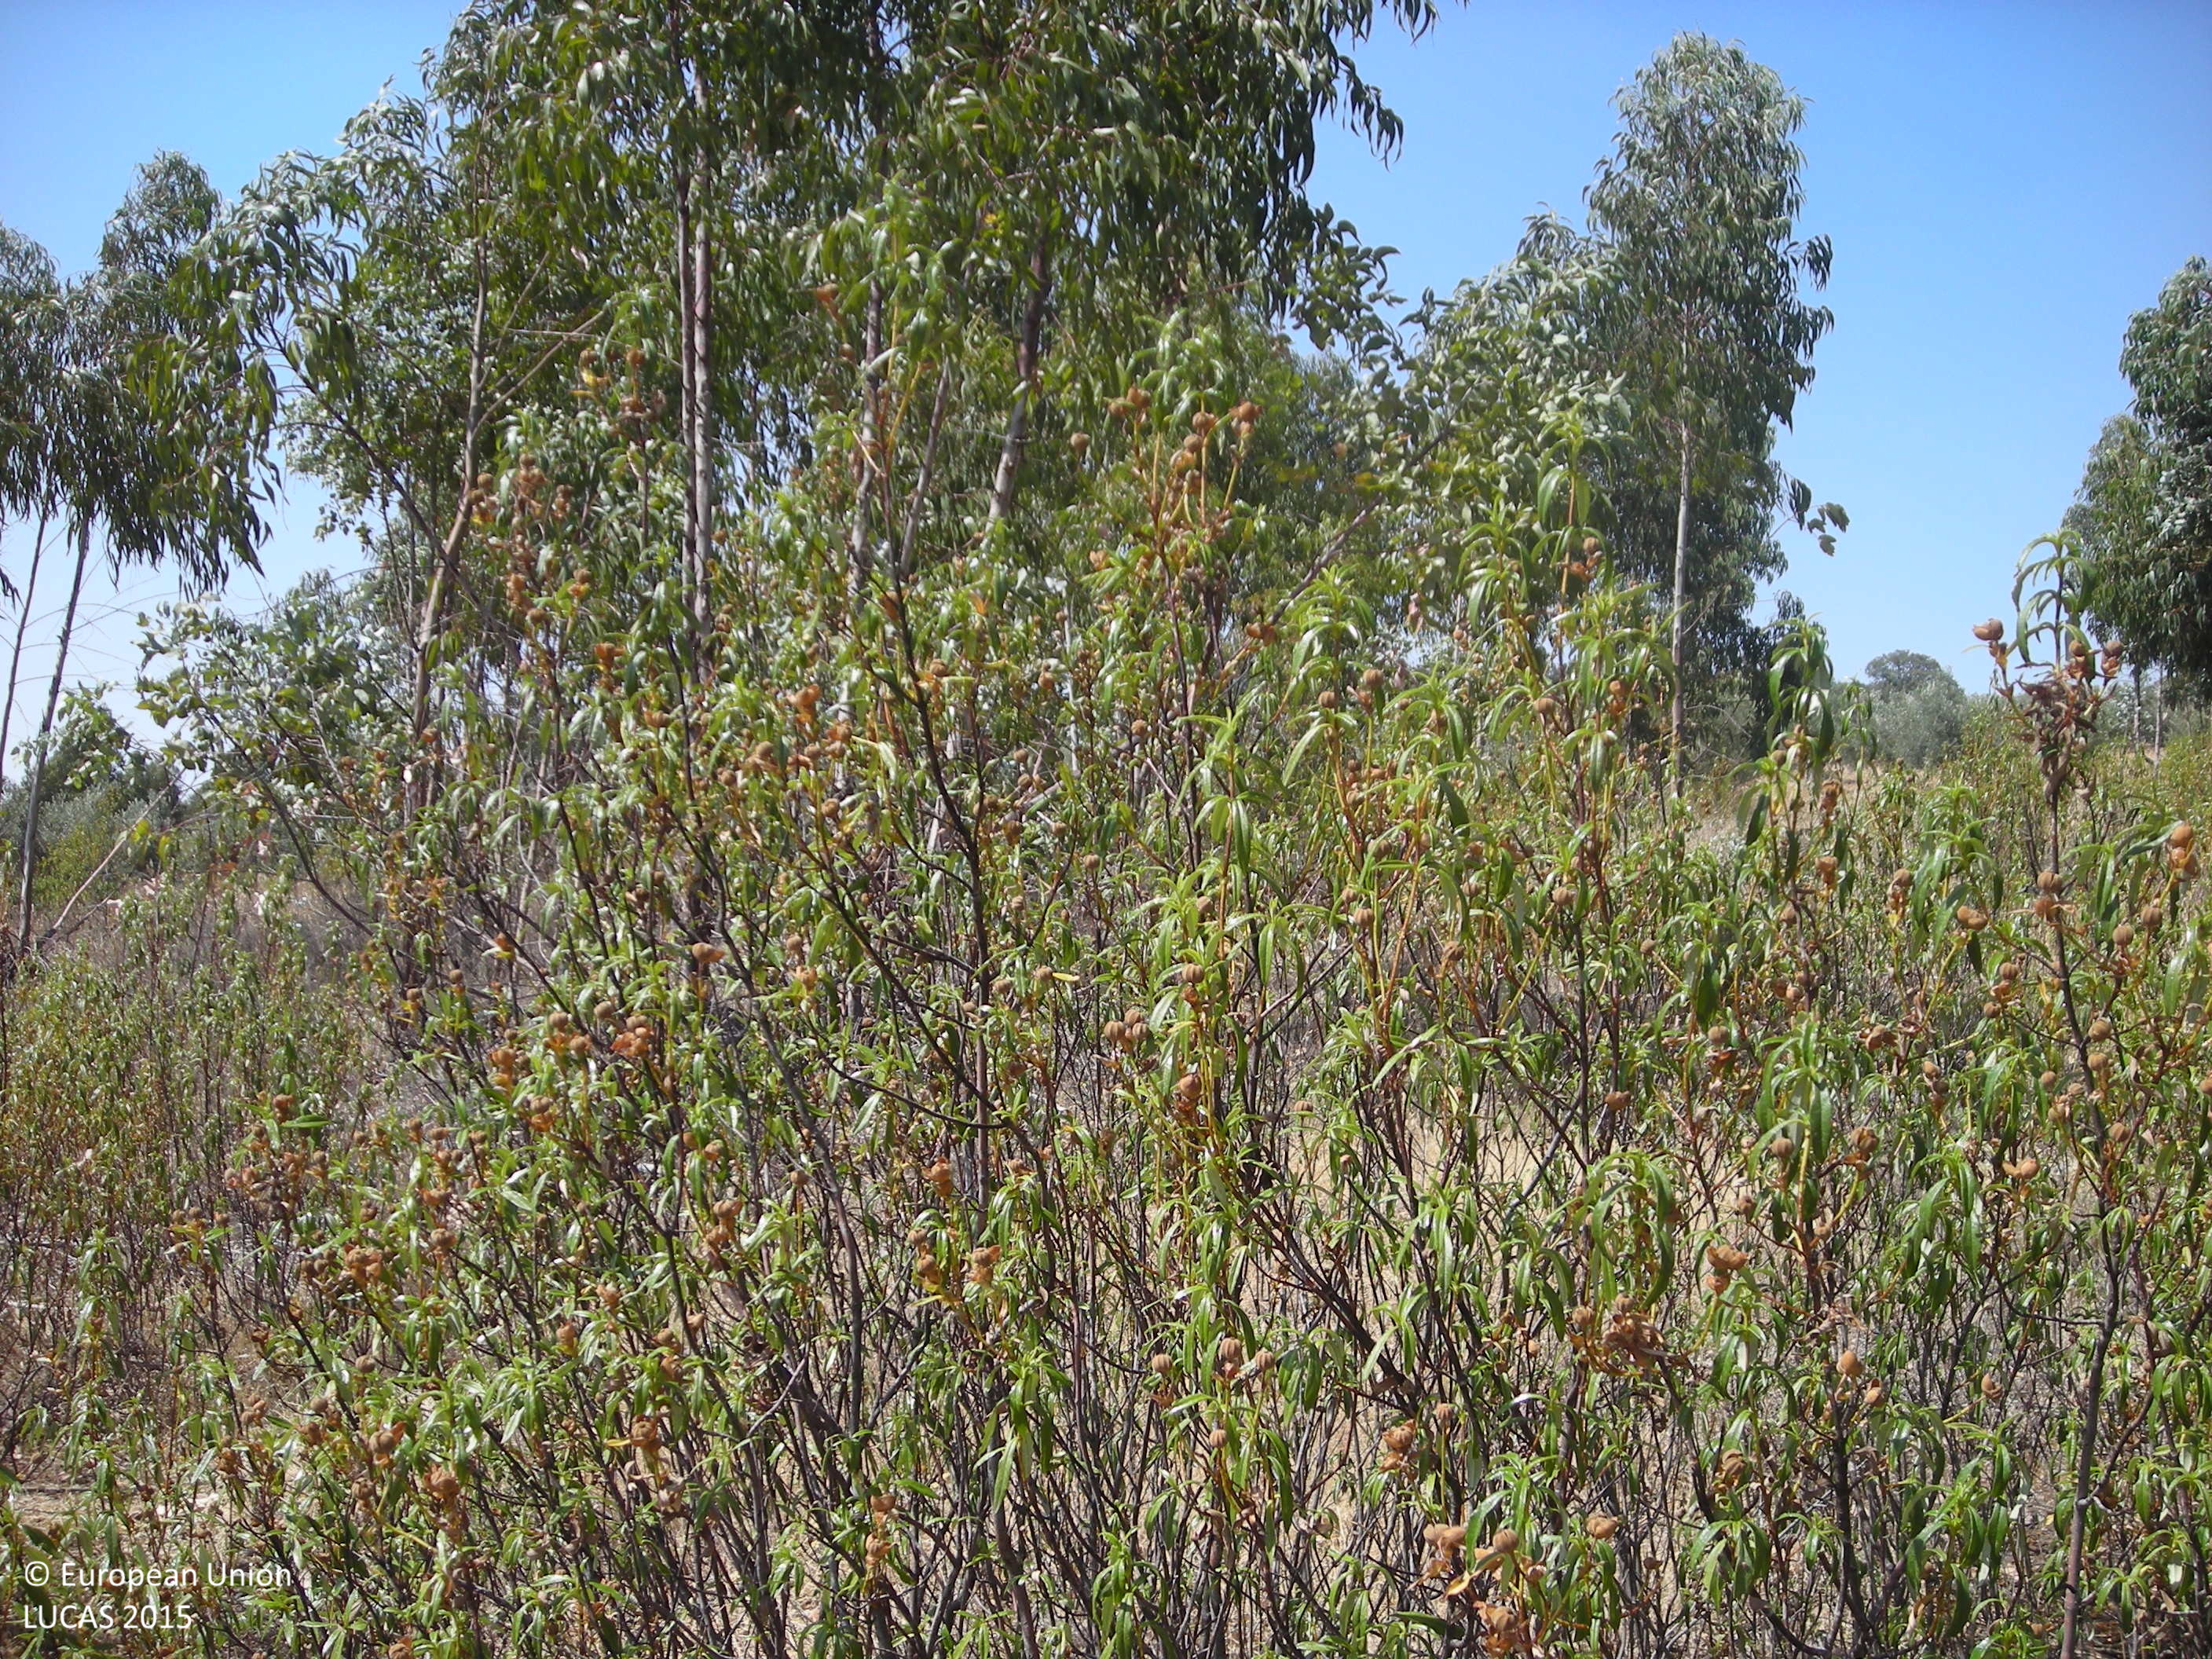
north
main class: Shrubland
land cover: Shrubland with sparse tree cover
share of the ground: > 75 %
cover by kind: shrubs 95 %, broadleaved forest trees 5 %
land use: Semi-natural and natural areas not in use
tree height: > 5 m
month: June
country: ES
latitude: 38.5794
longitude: -5.8726
